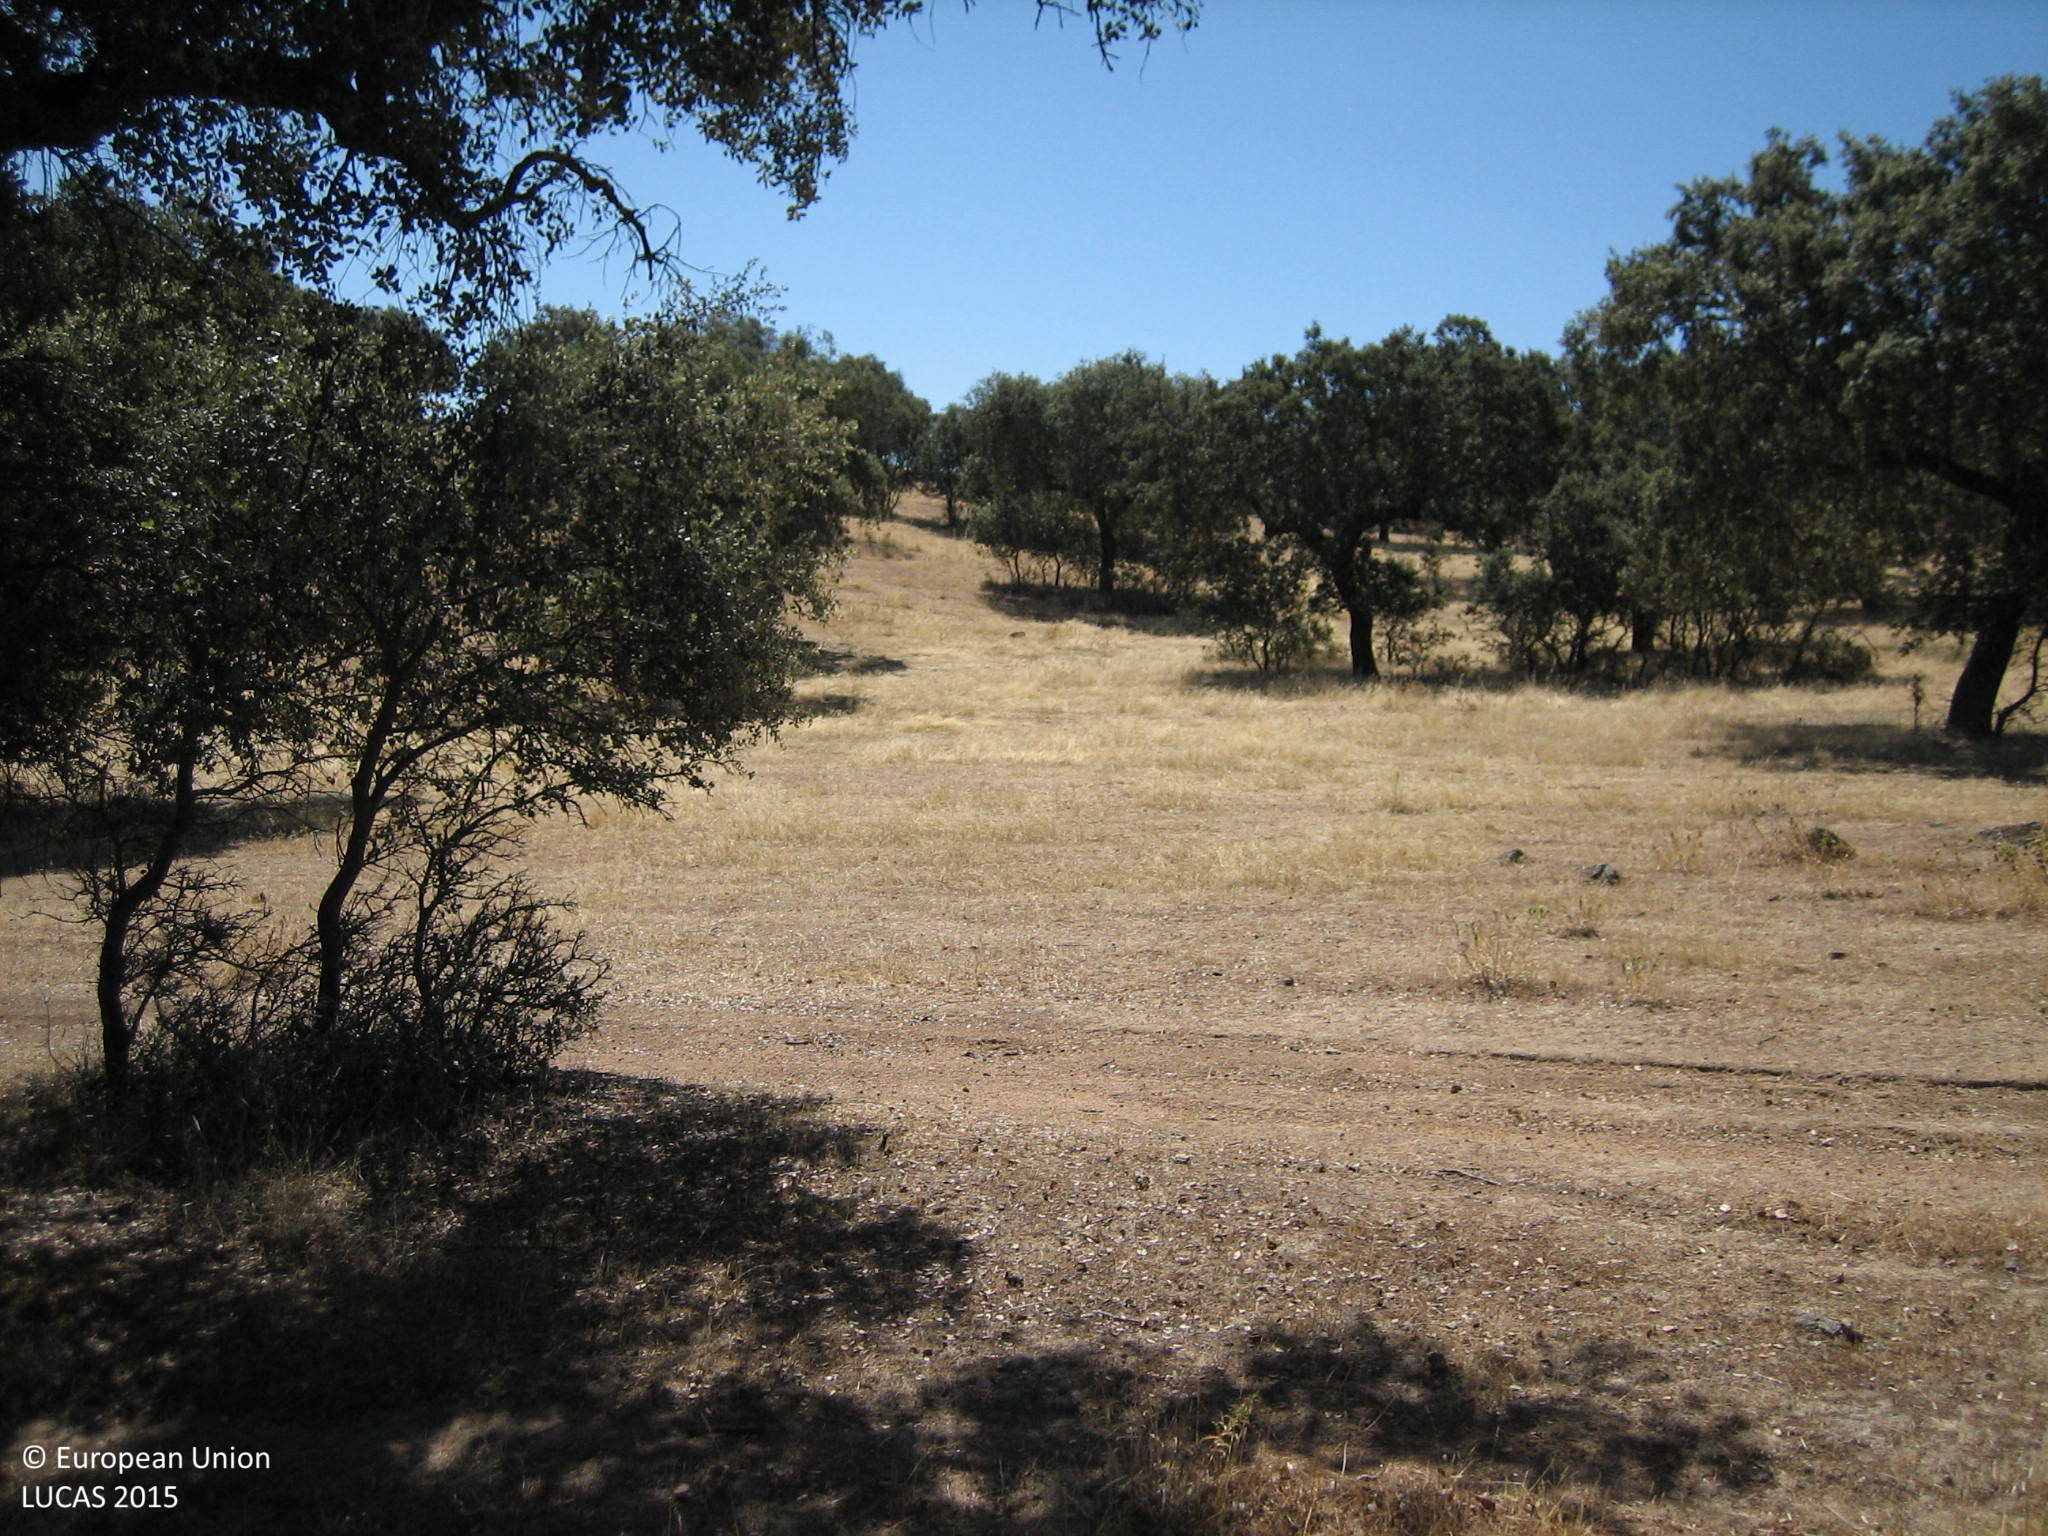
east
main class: Woodland
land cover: Broadleaved woodland
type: broadleaved evergreen forest
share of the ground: 10 - 25 %
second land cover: Grassland without tree/shrub cover
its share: 25 - 50 %
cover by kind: consolidated bare surface 50 %, herbaceous plants 30 %, broadleaved forest trees 20 %
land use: Forestry
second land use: Agriculture (excluding fallow land and kitchen gardens)
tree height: > 5 m
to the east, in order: Broadleaved woodland; Grassland without tree/shrub cover
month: July
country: ES
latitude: 38.4948
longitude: -6.1558
